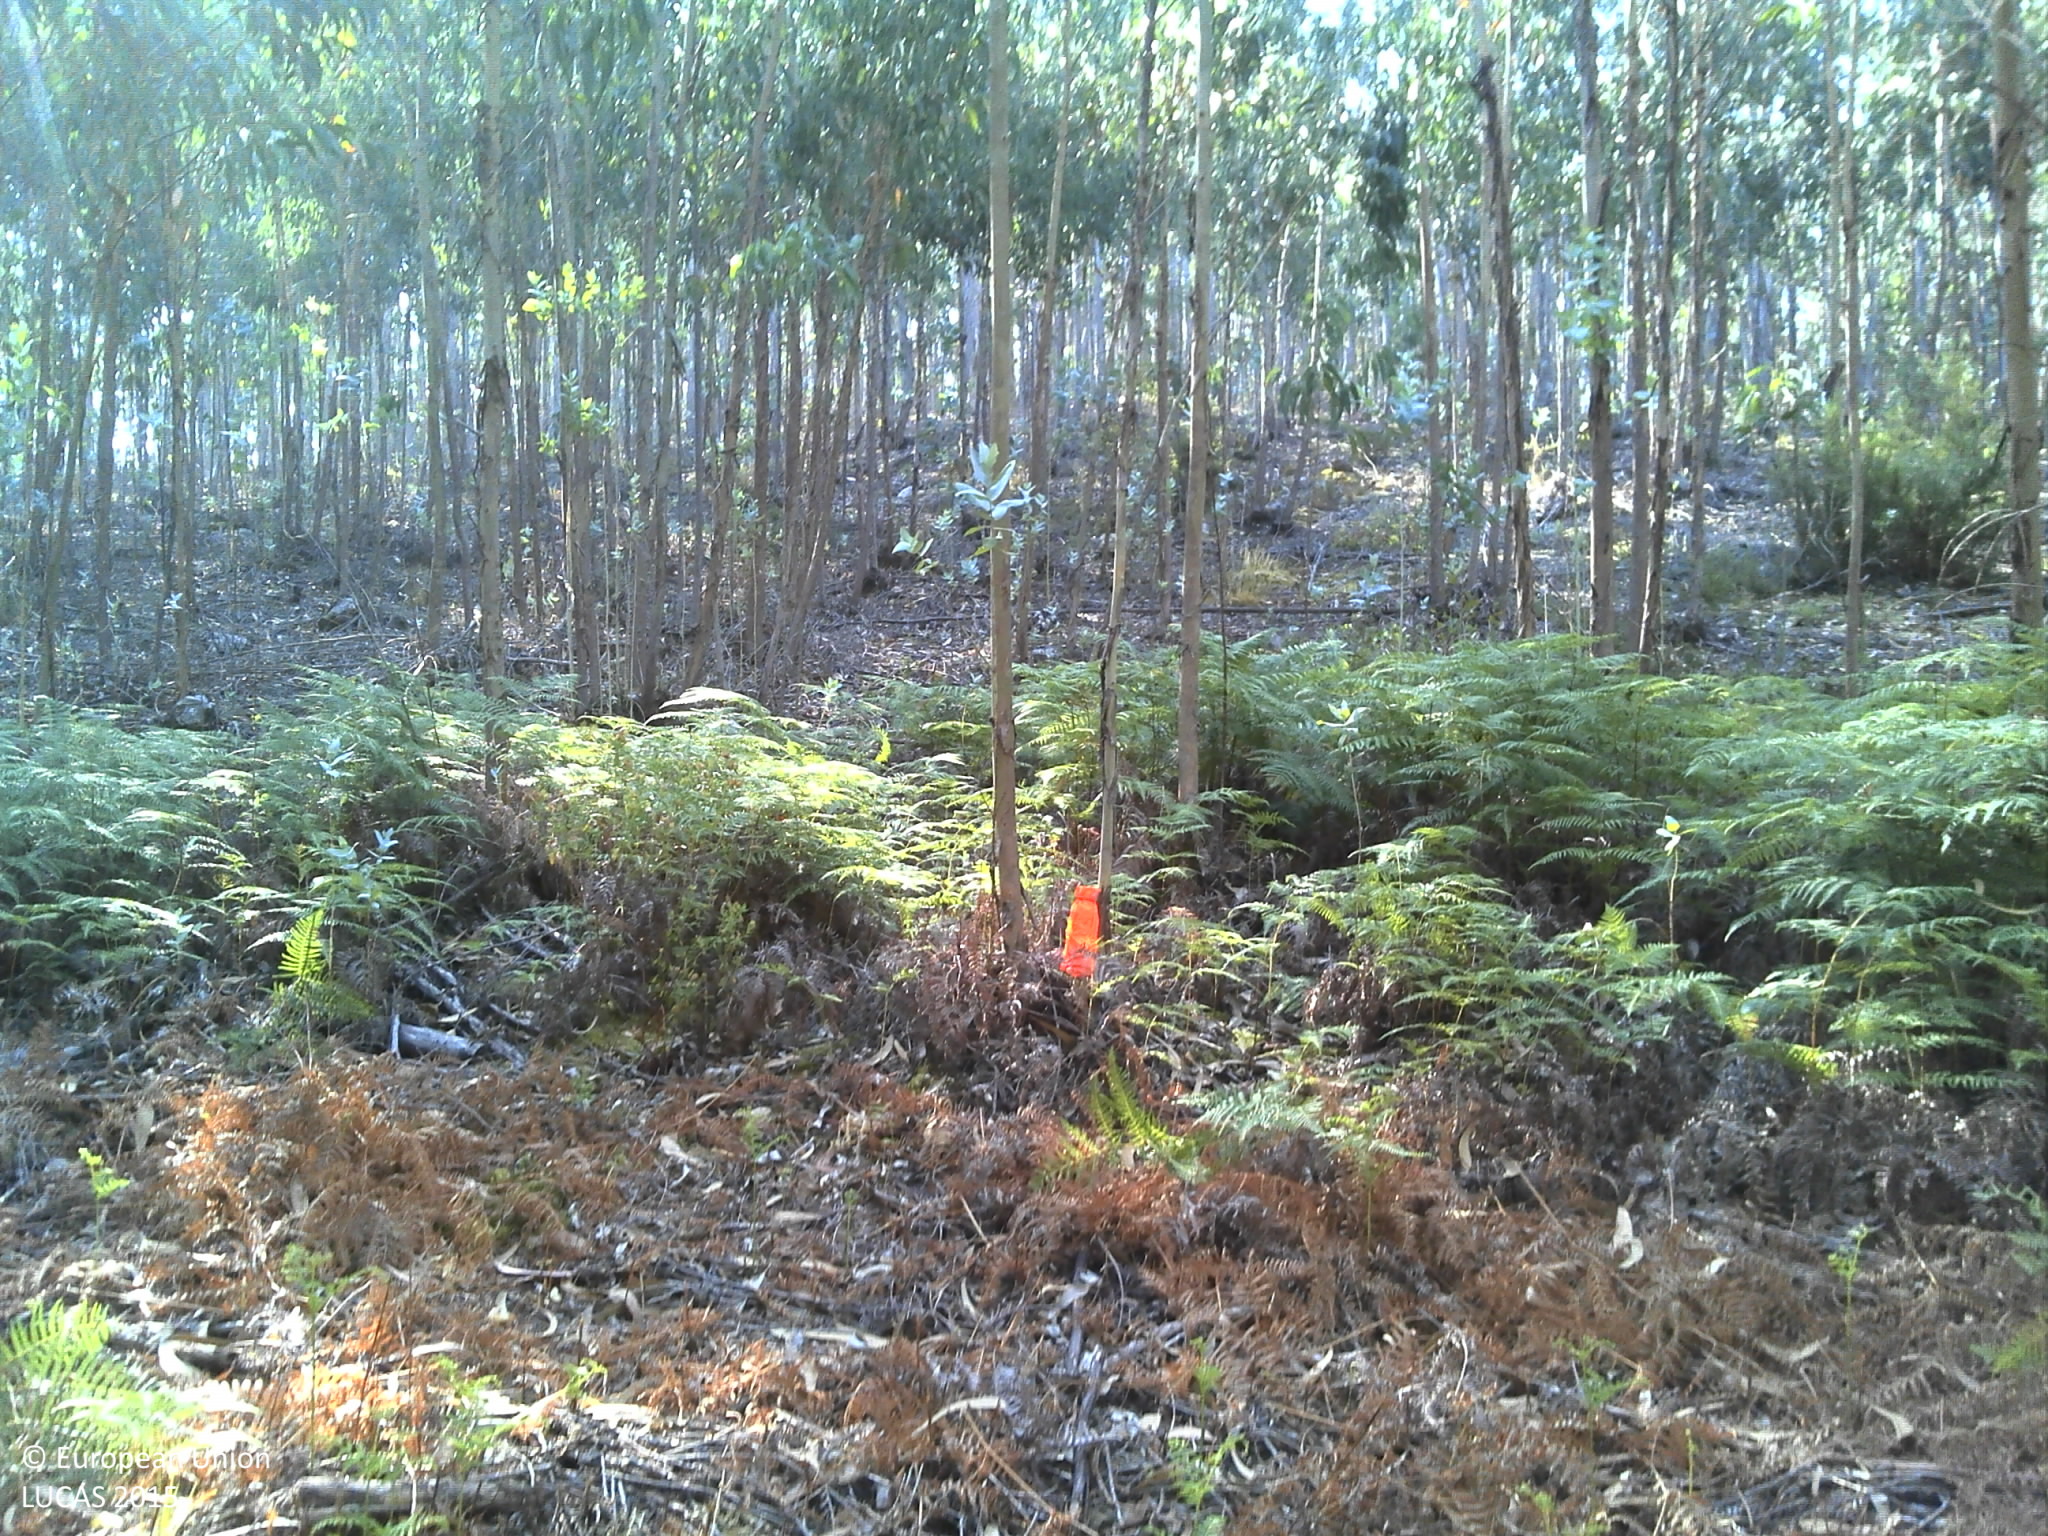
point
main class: Woodland
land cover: Broadleaved woodland
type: exotic forest
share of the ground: > 75 %
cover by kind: broadleaved forest trees 75 %, unconsolidated bare surface 20 %, shrubs 5 %
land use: Forestry
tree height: > 5 m
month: June
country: PT
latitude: 39.1188
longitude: -9.2516
